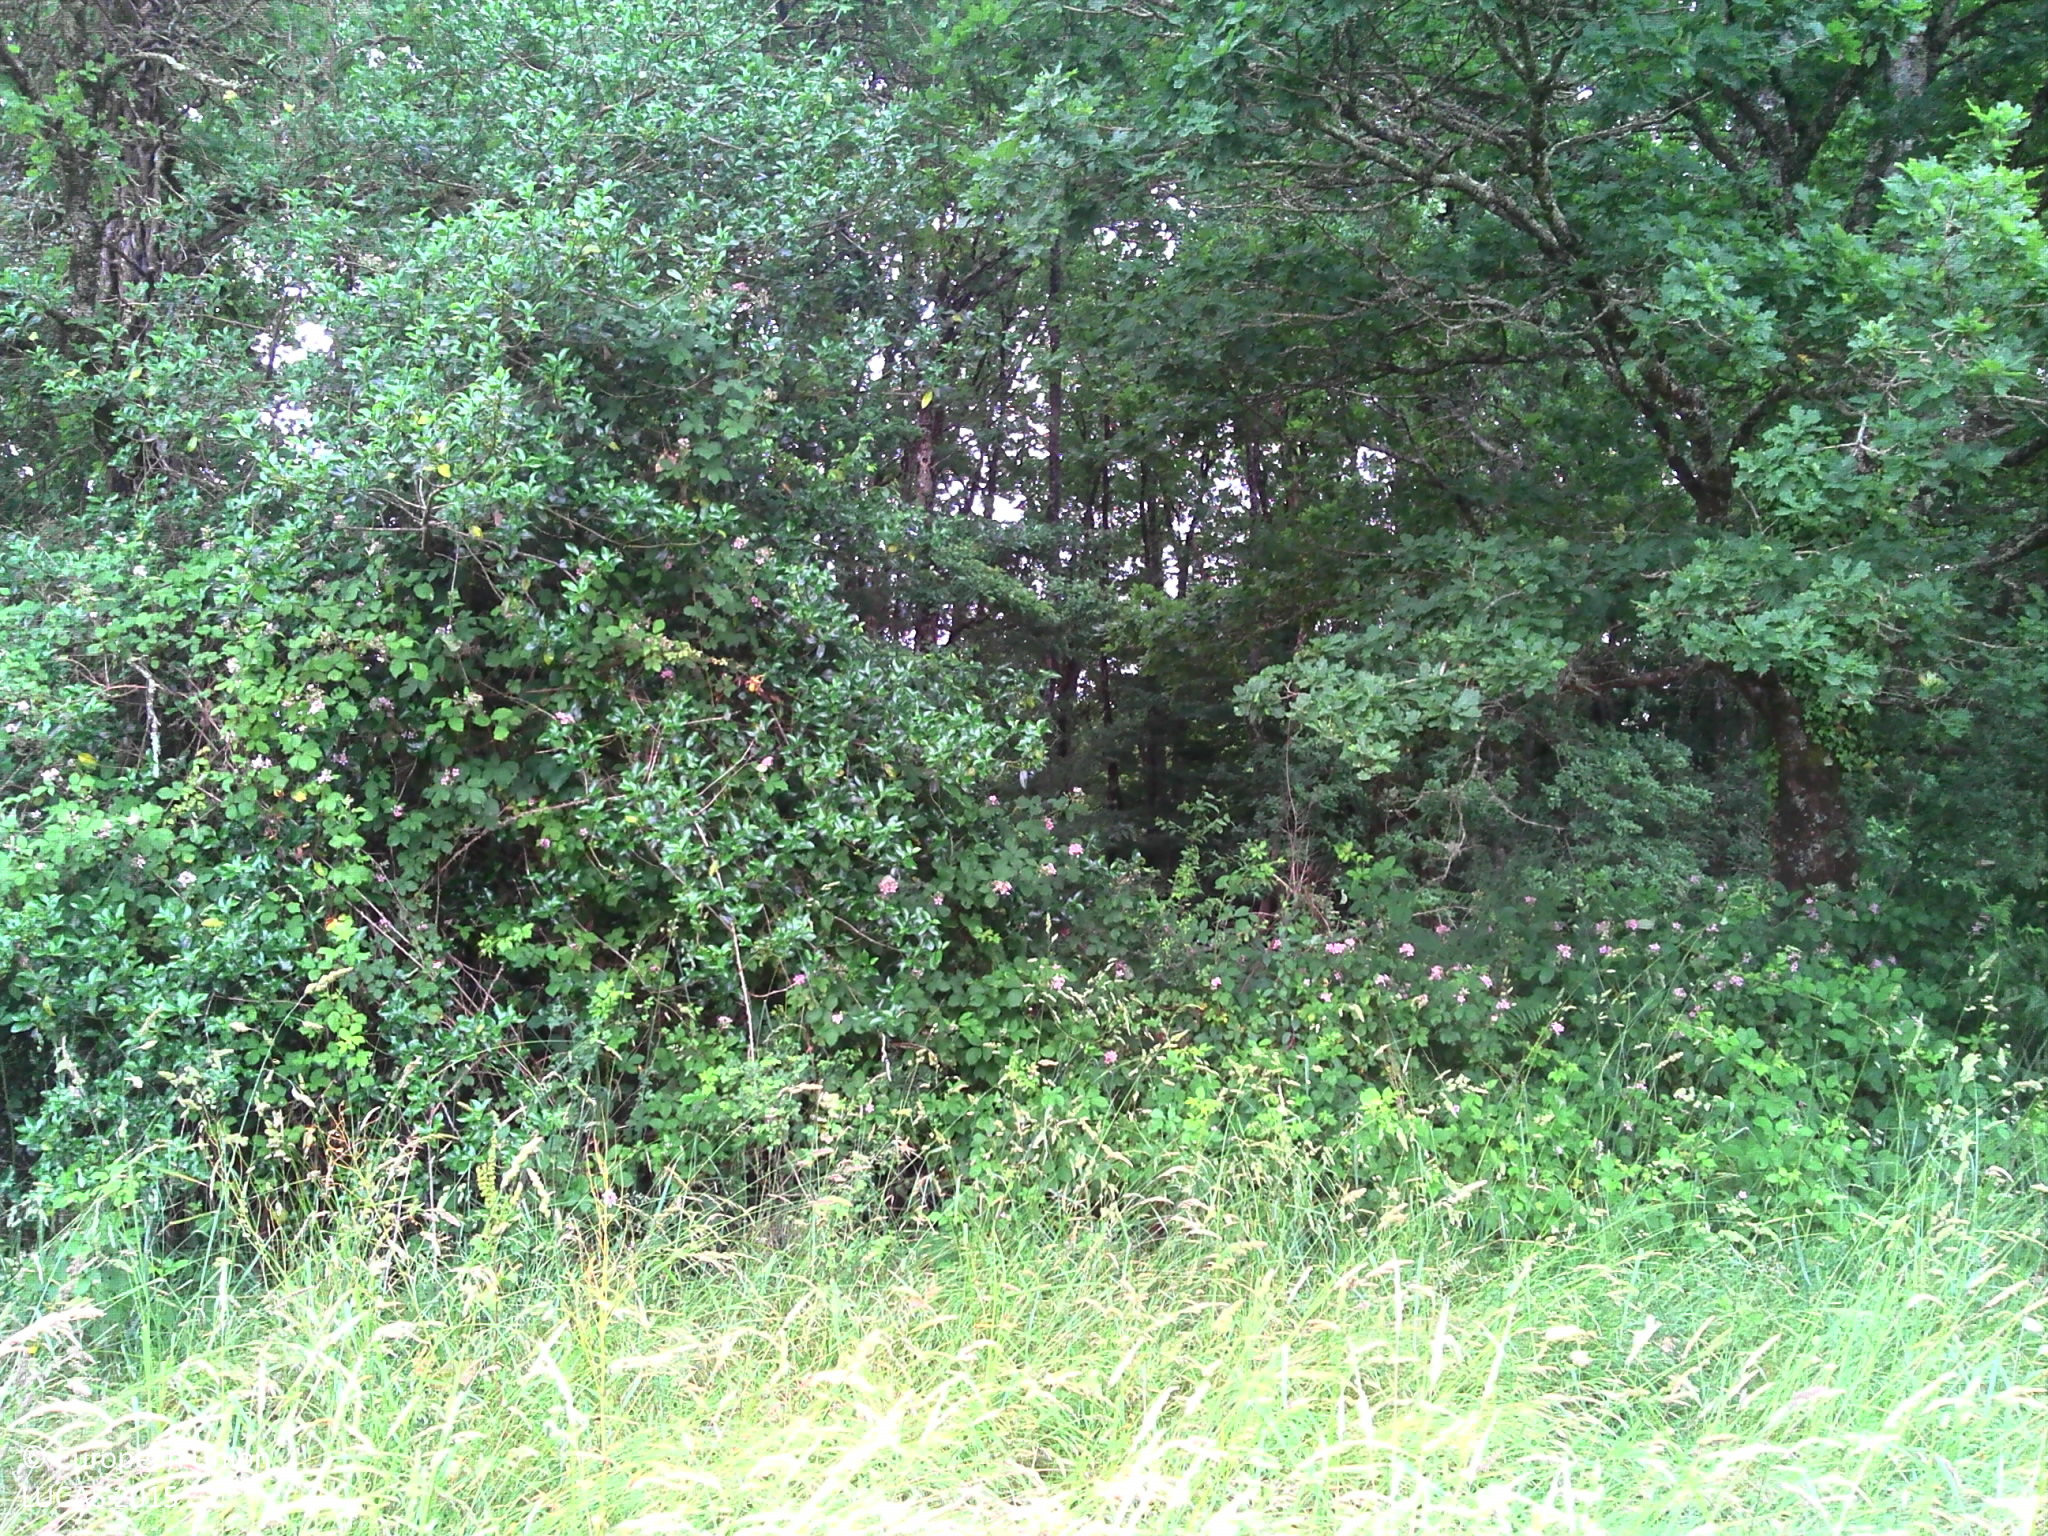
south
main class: Grassland
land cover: Grassland without tree/shrub cover
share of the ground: > 75 %
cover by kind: herbaceous plants 100 %
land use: Agriculture (excluding fallow land and kitchen gardens)
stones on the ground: < 10 %
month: June
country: FR
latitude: 45.9505
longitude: 0.5548
